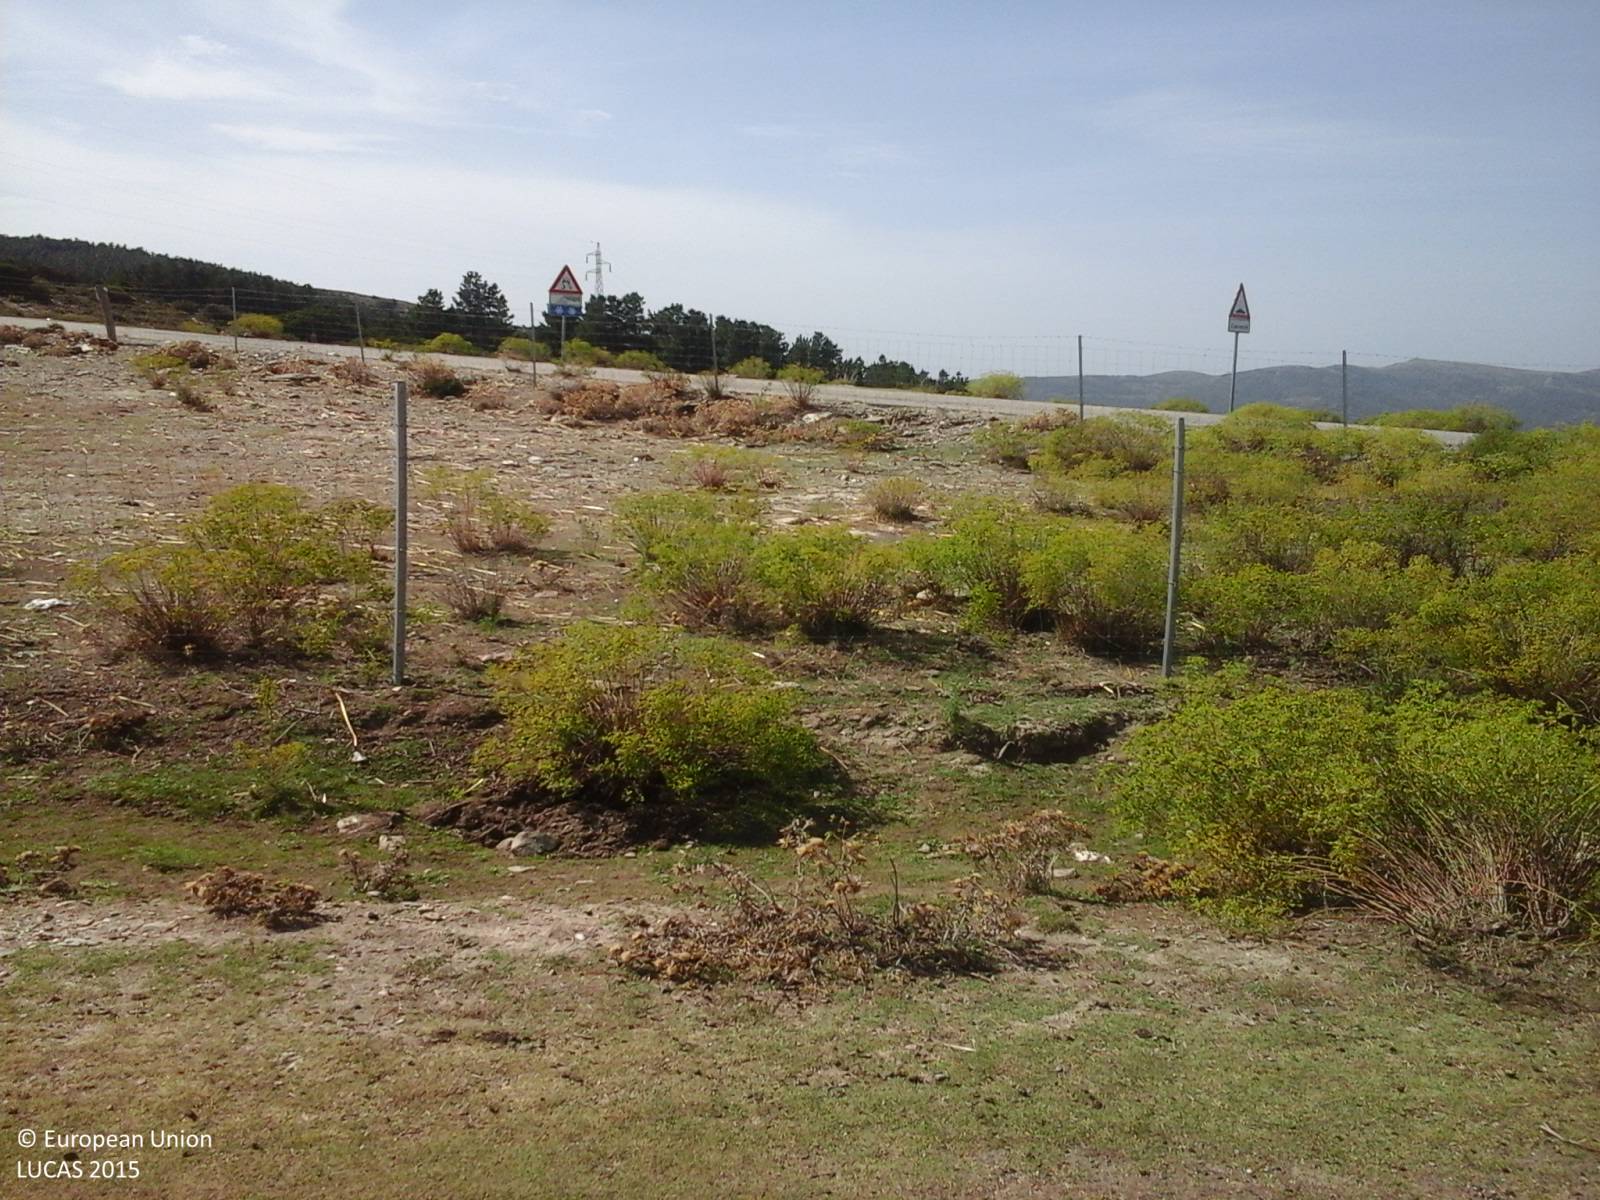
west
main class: Grassland
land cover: Grassland without tree/shrub cover
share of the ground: > 75 %
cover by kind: unconsolidated bare surface 40 %, herbaceous plants 35 %, consolidated bare surface 25 %
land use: Agriculture (excluding fallow land and kitchen gardens)
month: September
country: IT
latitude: 39.8126
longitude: 9.3611
